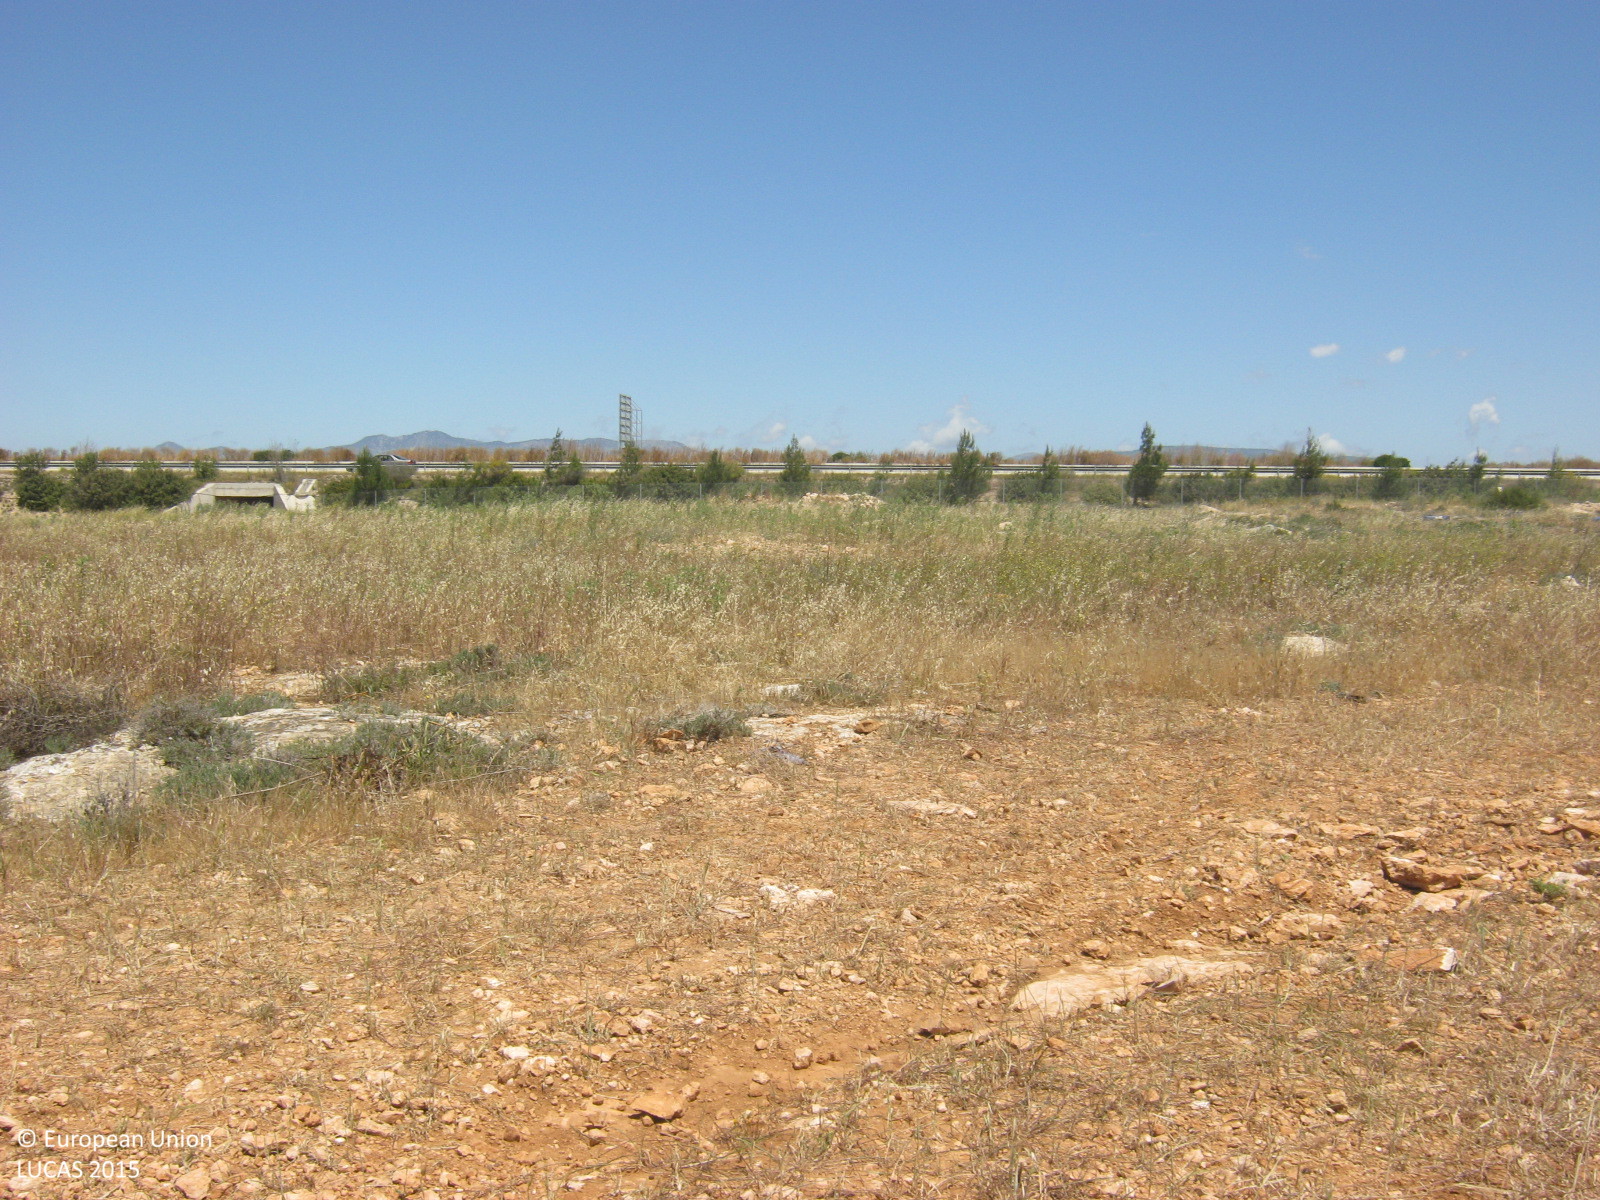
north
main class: Grassland
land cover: Spontaneously vegetated surfaces
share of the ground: 50 - 75 %
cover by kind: herbaceous plants 65 %, unconsolidated bare surface 30 %, shrubs 5 %
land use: Agriculture (excluding fallow land and kitchen gardens)
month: May
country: CY
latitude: 35.1591
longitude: 33.1855
